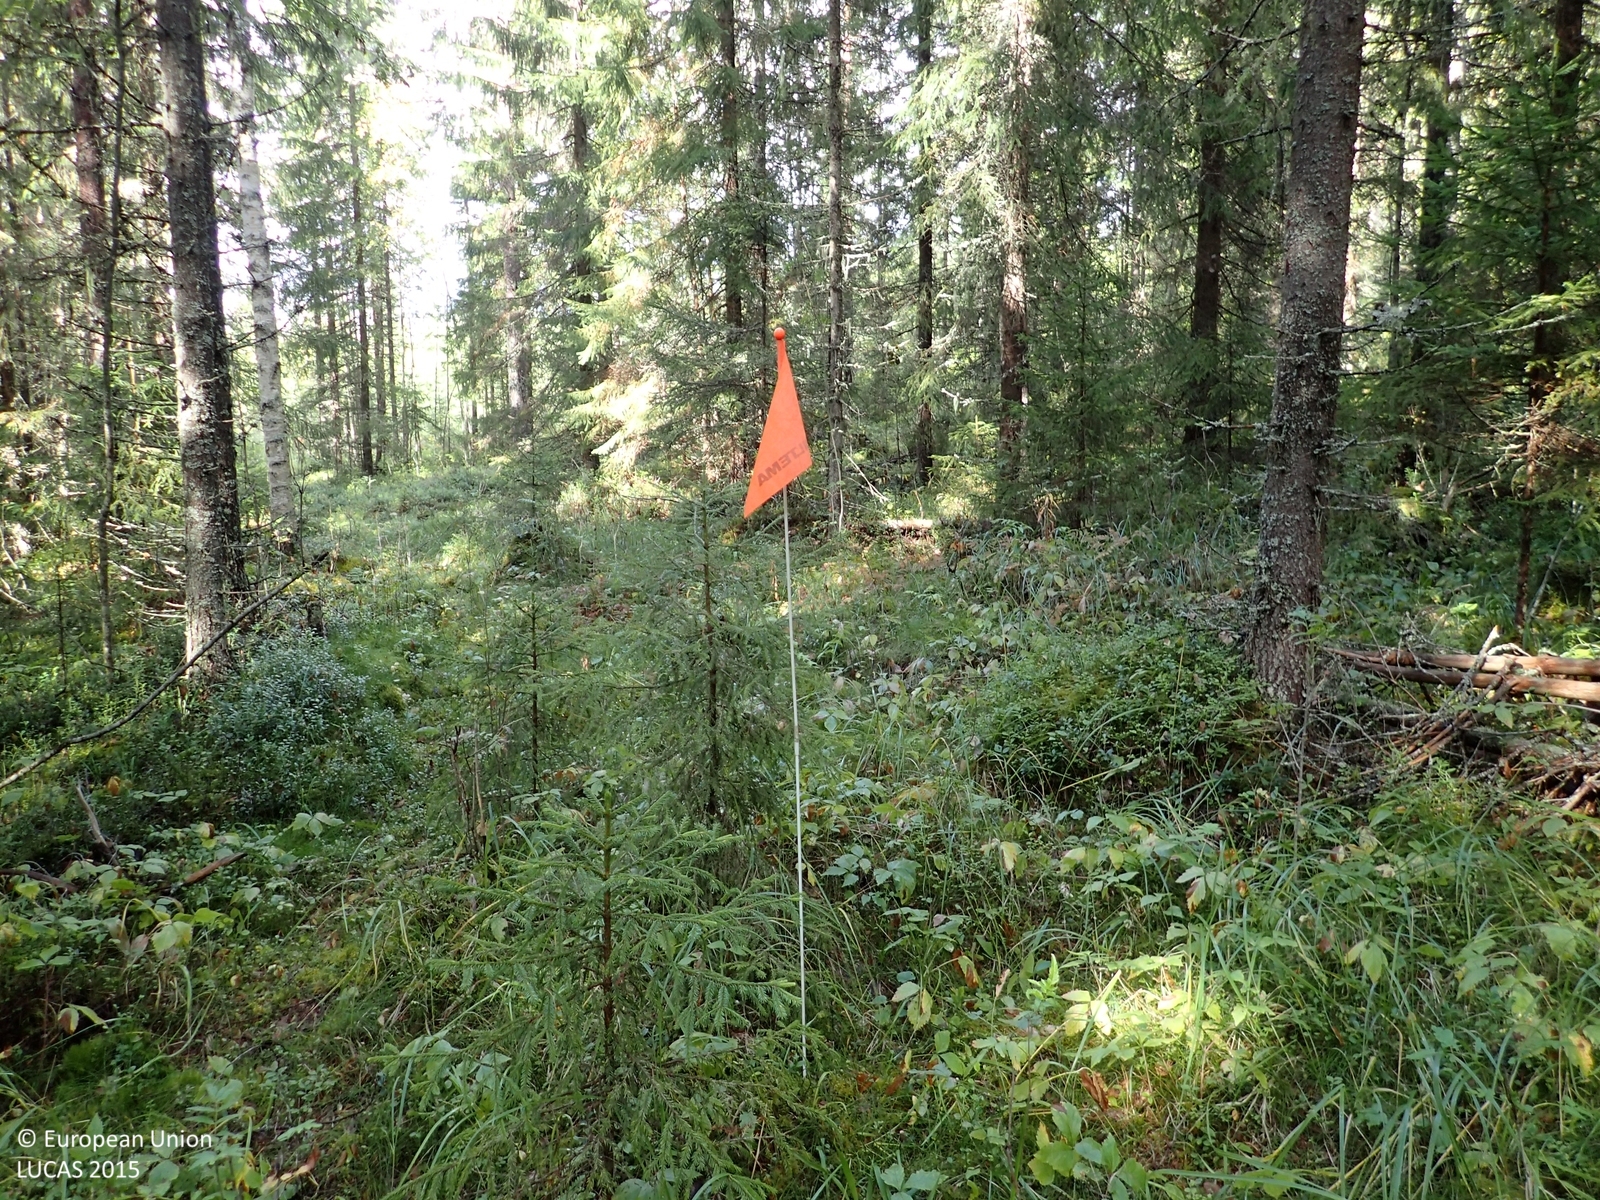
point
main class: Woodland
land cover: Spruce dominated mixed woodland
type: boreal forest
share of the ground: > 75 %
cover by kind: coniferous forest trees 55 %, broadleaved forest trees 20 %, shrubs 10 %, herbaceous plants 10 %, lichens and mosses 5 %
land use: Forestry
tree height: > 5 m
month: September
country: FI
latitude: 63.1890
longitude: 25.8316
